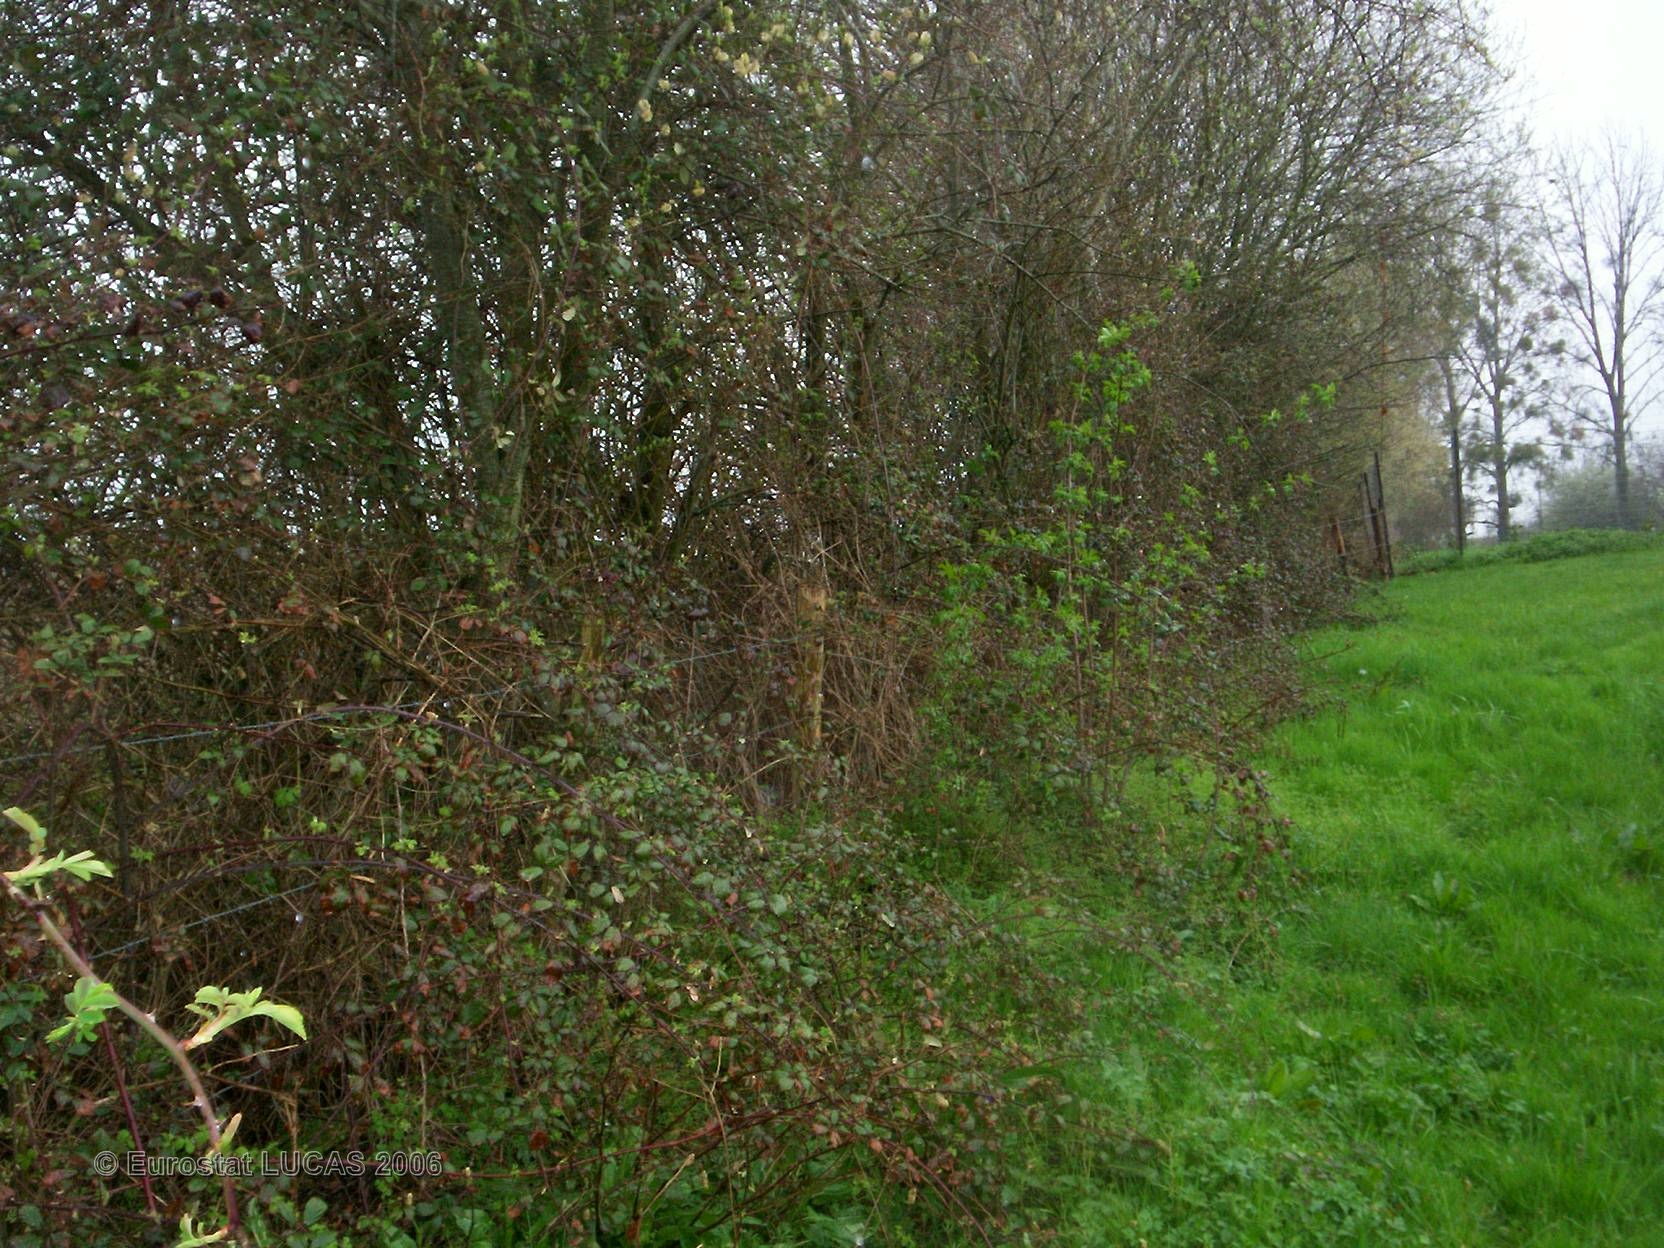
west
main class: Grassland
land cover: Grassland without tree/shrub cover
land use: Agriculture (excluding fallow land and kitchen gardens)
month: April
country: FR
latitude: 48.3575
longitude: 0.1064
